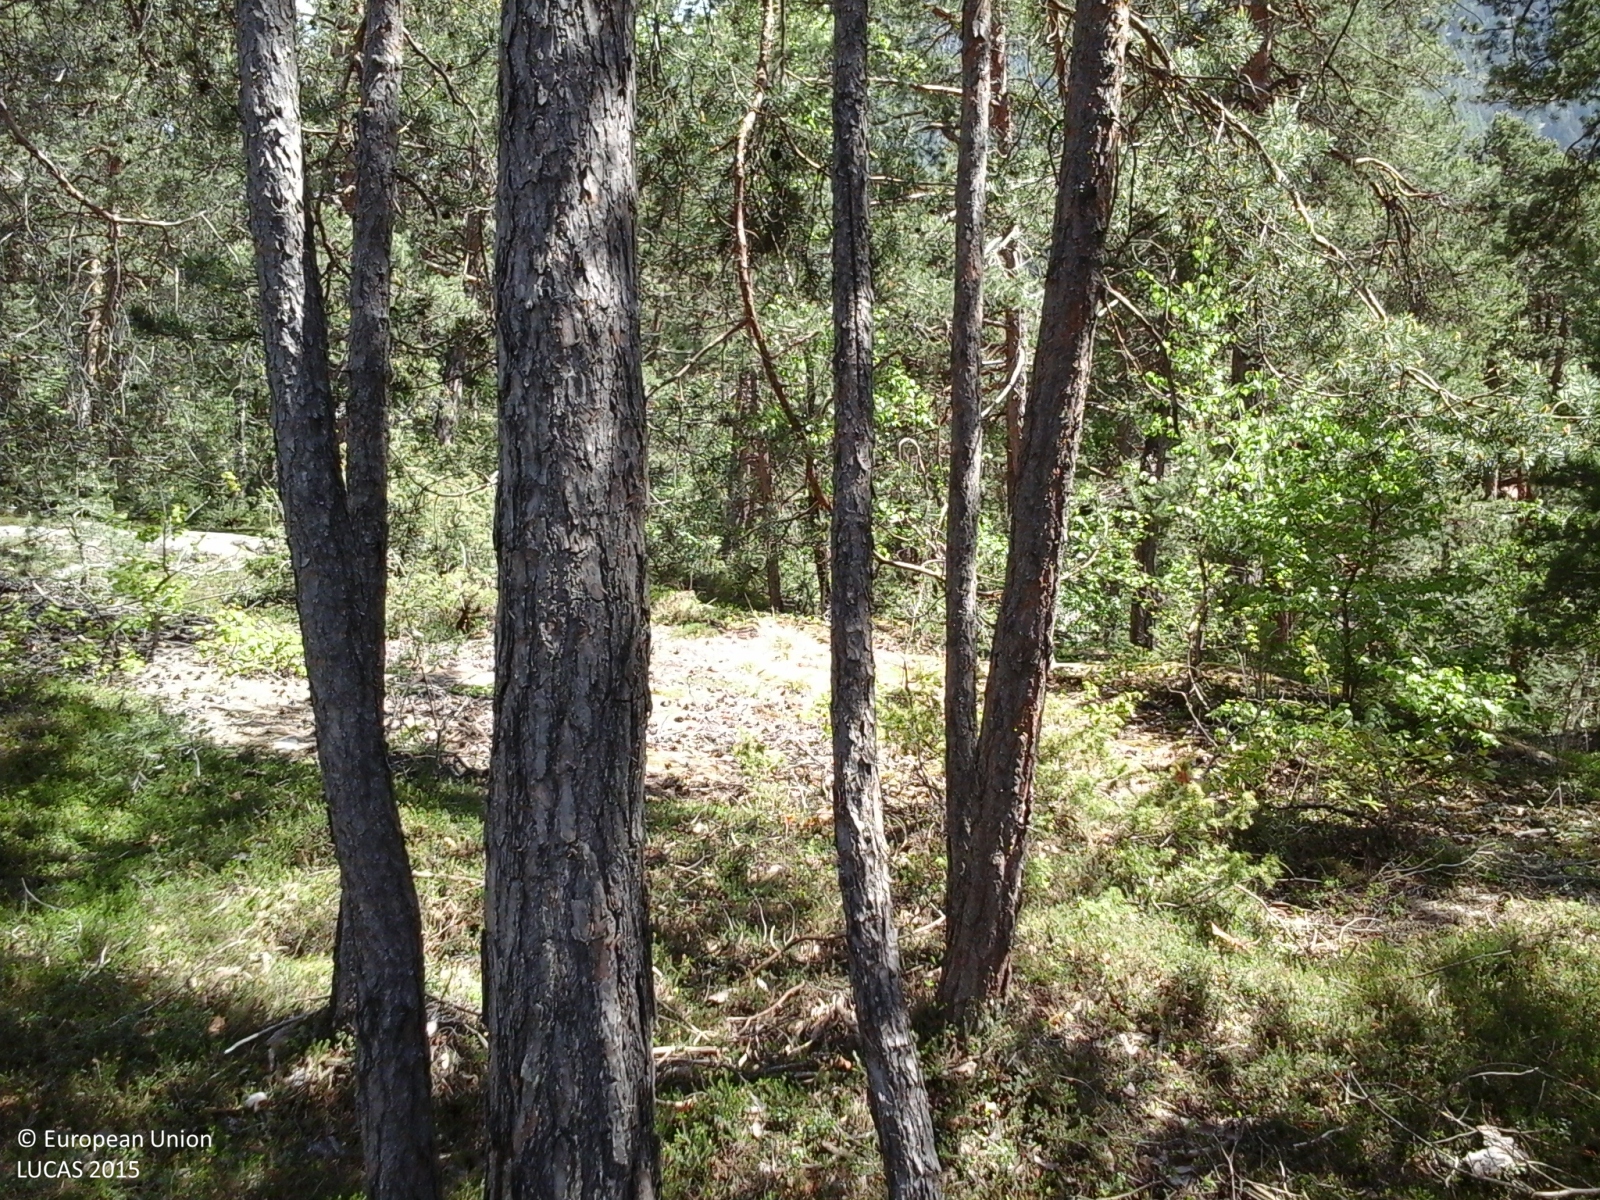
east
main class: Woodland
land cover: Pine dominated coniferous woodland
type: alpine coniferous forest
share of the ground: > 75 %
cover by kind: coniferous forest trees 100 %
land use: Forestry
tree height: > 5 m
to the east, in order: Pine dominated coniferous woodland; Grassland without tree/shrub cover; Artificial constructions in urban areas; Grassland without tree/shrub cover; Paved roads, cycling and walking lanes; Spontaneously vegetated surfaces; Electric lines; Grassland without tree/shrub cover; Shrubland without tree cover; Paved roads, cycling and walking lanes; Grassland without tree/shrub cover
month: May
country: IT
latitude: 46.5738
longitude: 11.5770
